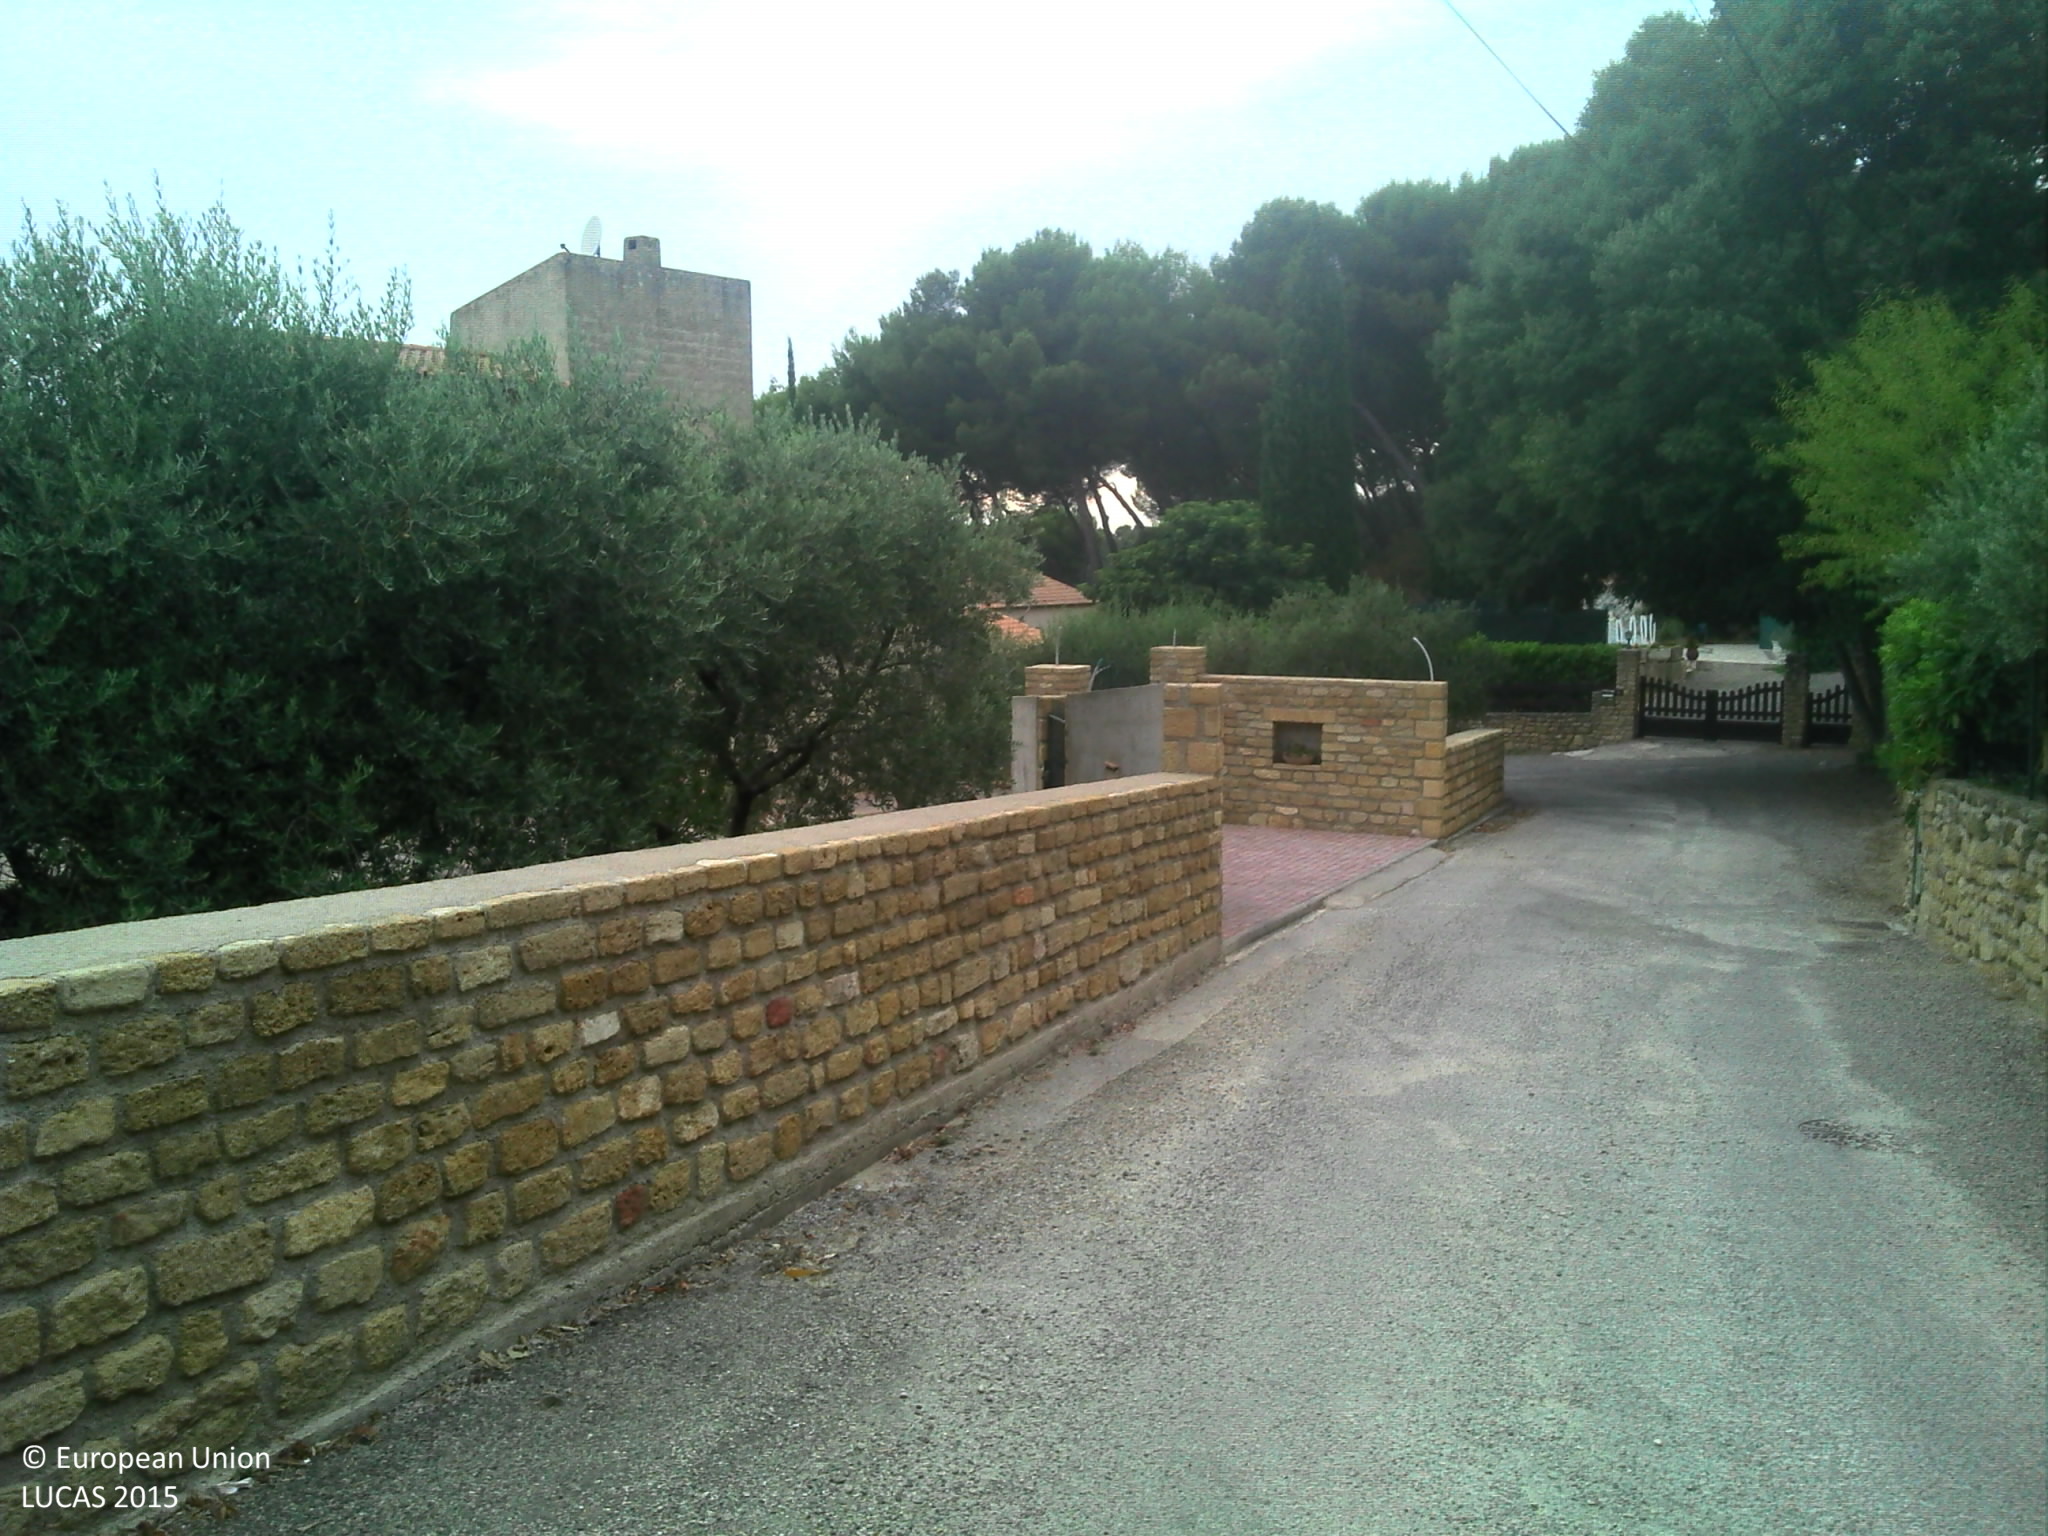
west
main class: Woodland
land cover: Other coniferous woodland
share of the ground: > 75 %
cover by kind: coniferous forest trees 30 %, herbaceous plants 25 %, consolidated bare surface 10 %
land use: Residential
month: July
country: FR
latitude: 43.5647
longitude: 5.0698
